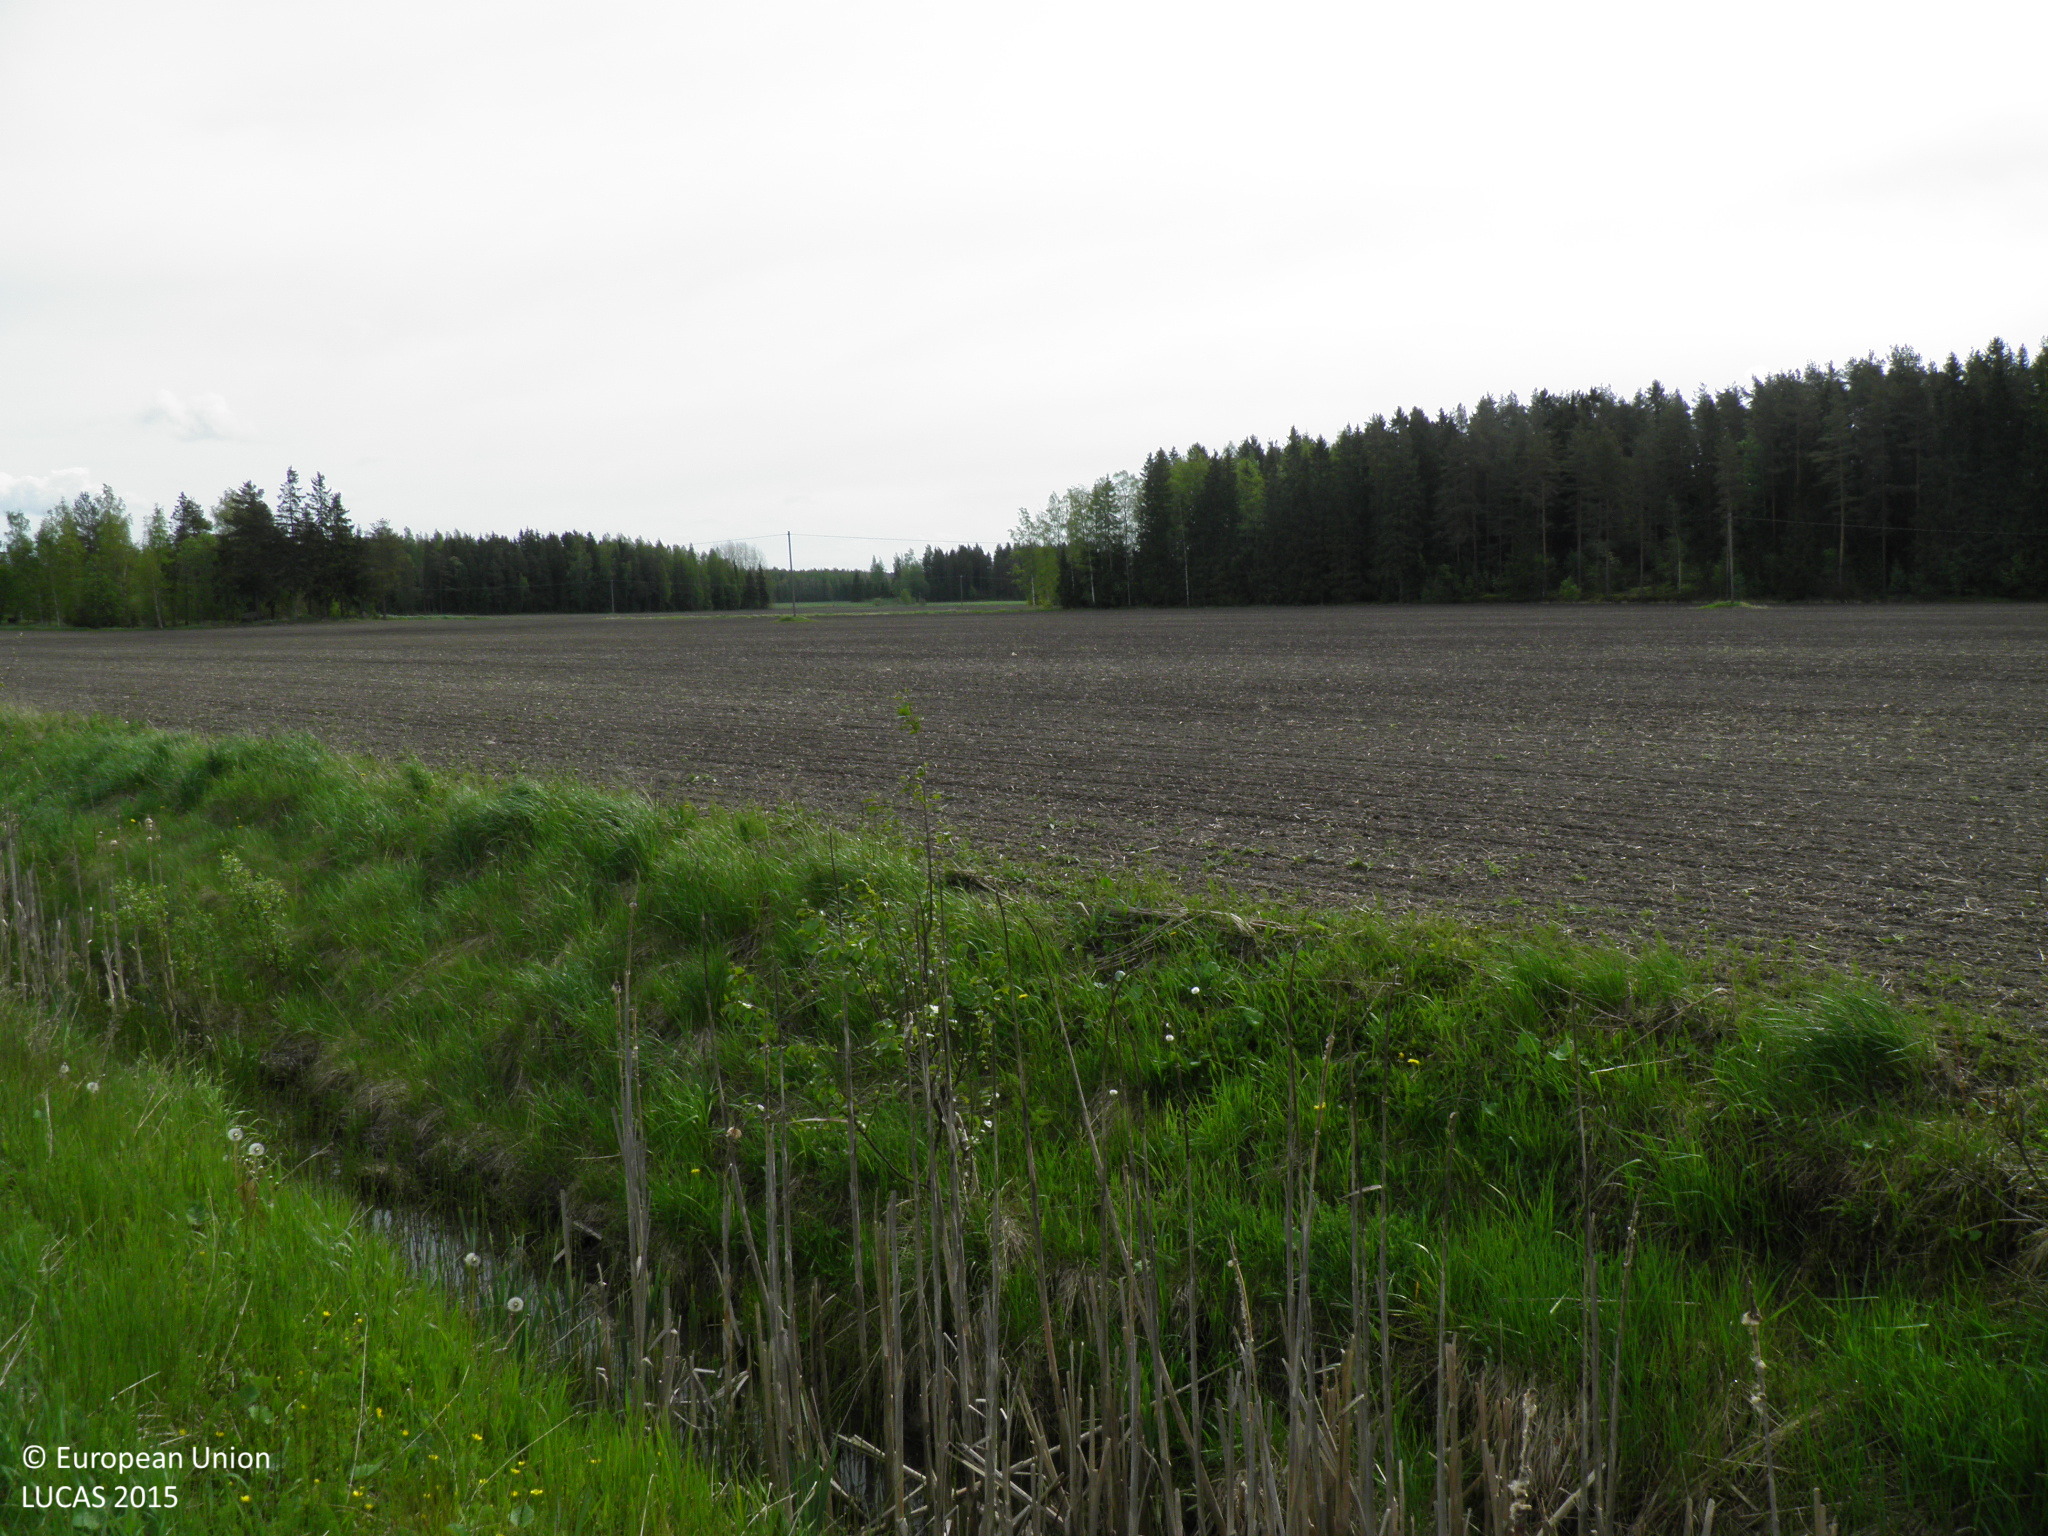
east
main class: Cropland
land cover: Common wheat
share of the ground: < 10 %
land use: Agriculture (excluding fallow land and kitchen gardens)
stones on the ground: < 10 %
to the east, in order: Common wheat; Grass margins; Ditches and canals; Grass margins; Common wheat; Electric lines; Common wheat; Ditches and canals
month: June
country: FI
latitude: 60.5384
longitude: 22.6674
